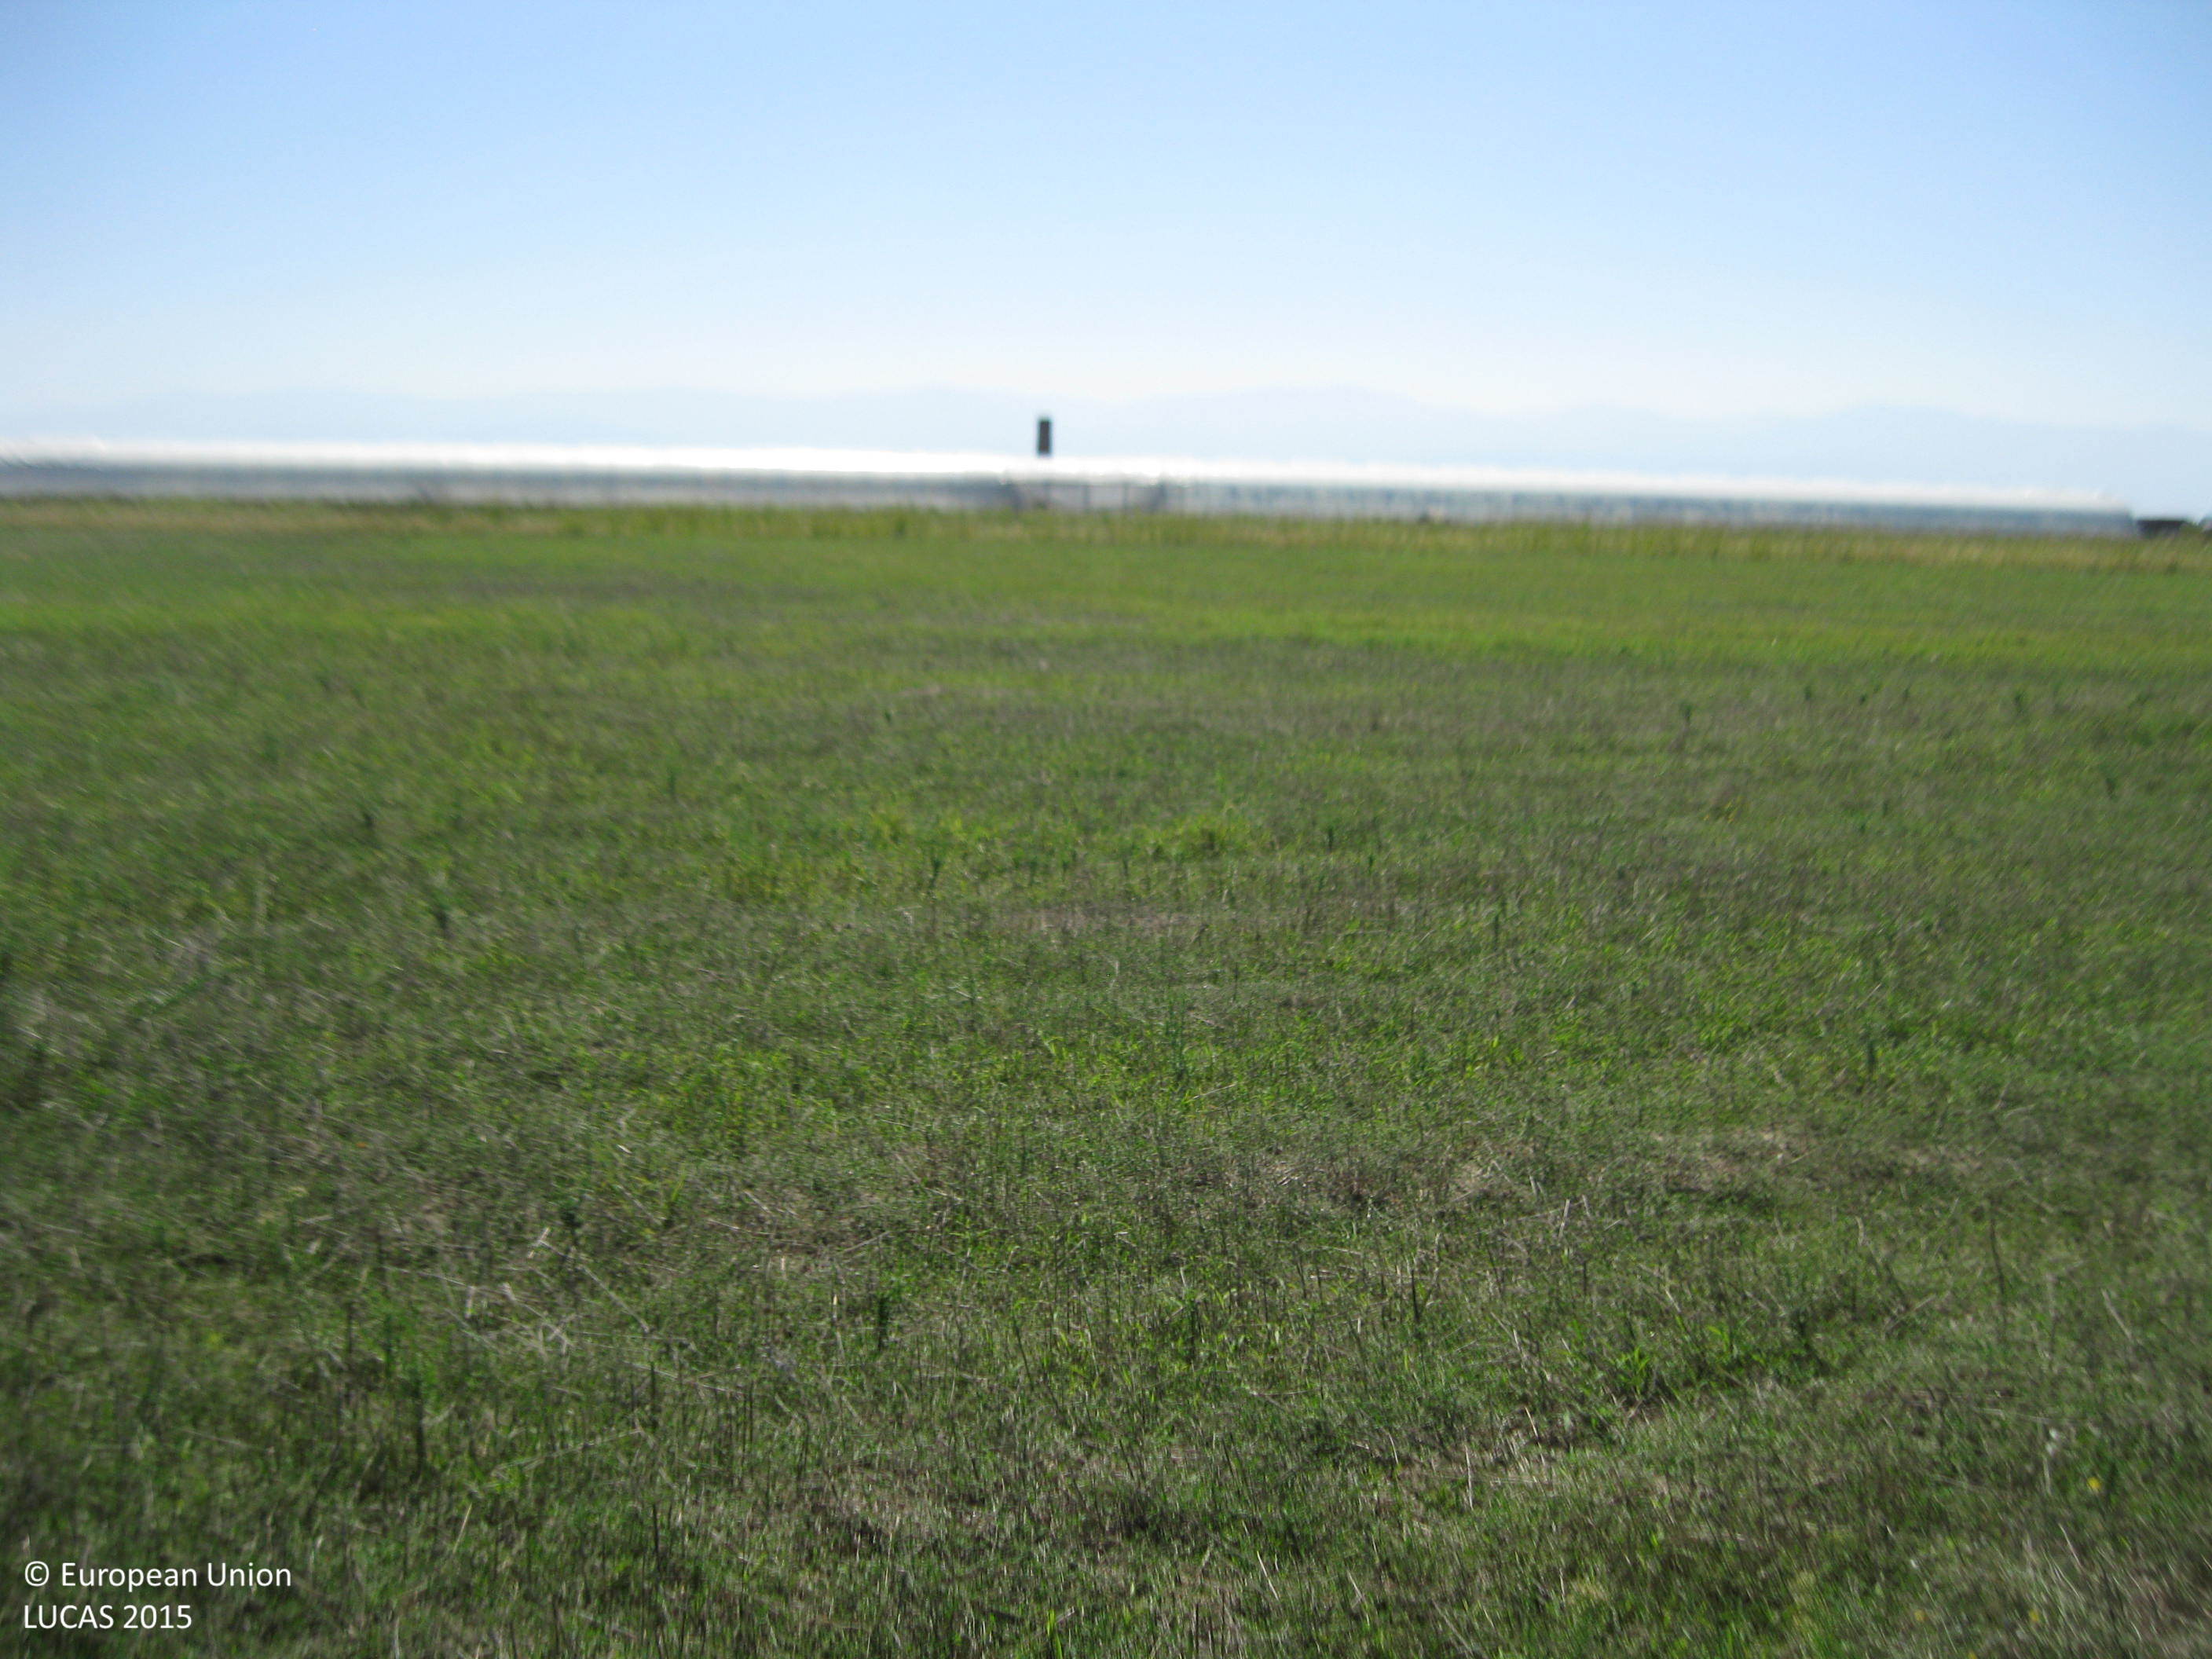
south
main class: Cropland
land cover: Common wheat
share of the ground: < 10 %
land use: Agriculture (excluding fallow land and kitchen gardens)
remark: Harvested field
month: September
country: BG
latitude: 42.2236
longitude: 24.6495
